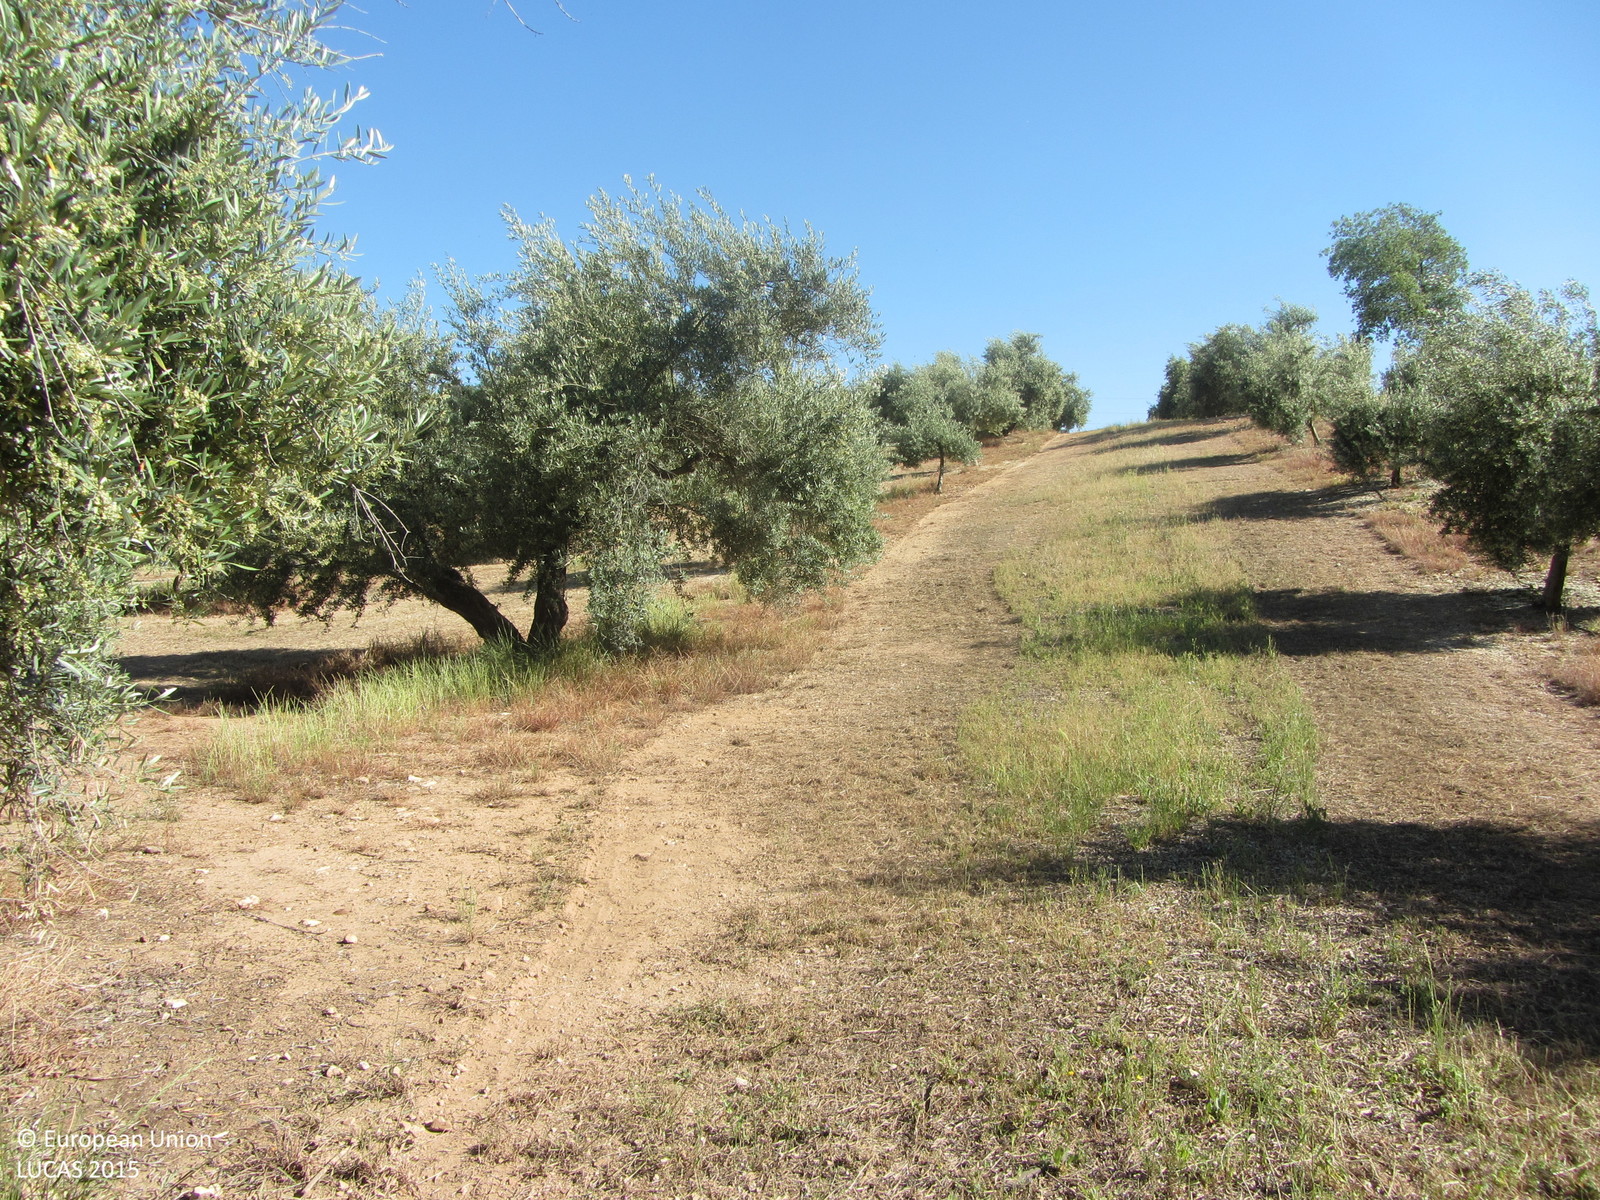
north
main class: Cropland
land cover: Olive groves
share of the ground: 25 - 50 %
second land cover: Spontaneously vegetated surfaces
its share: 25 - 50 %
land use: Agriculture (excluding fallow land and kitchen gardens)
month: May
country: ES
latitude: 38.1946
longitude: -3.0968
